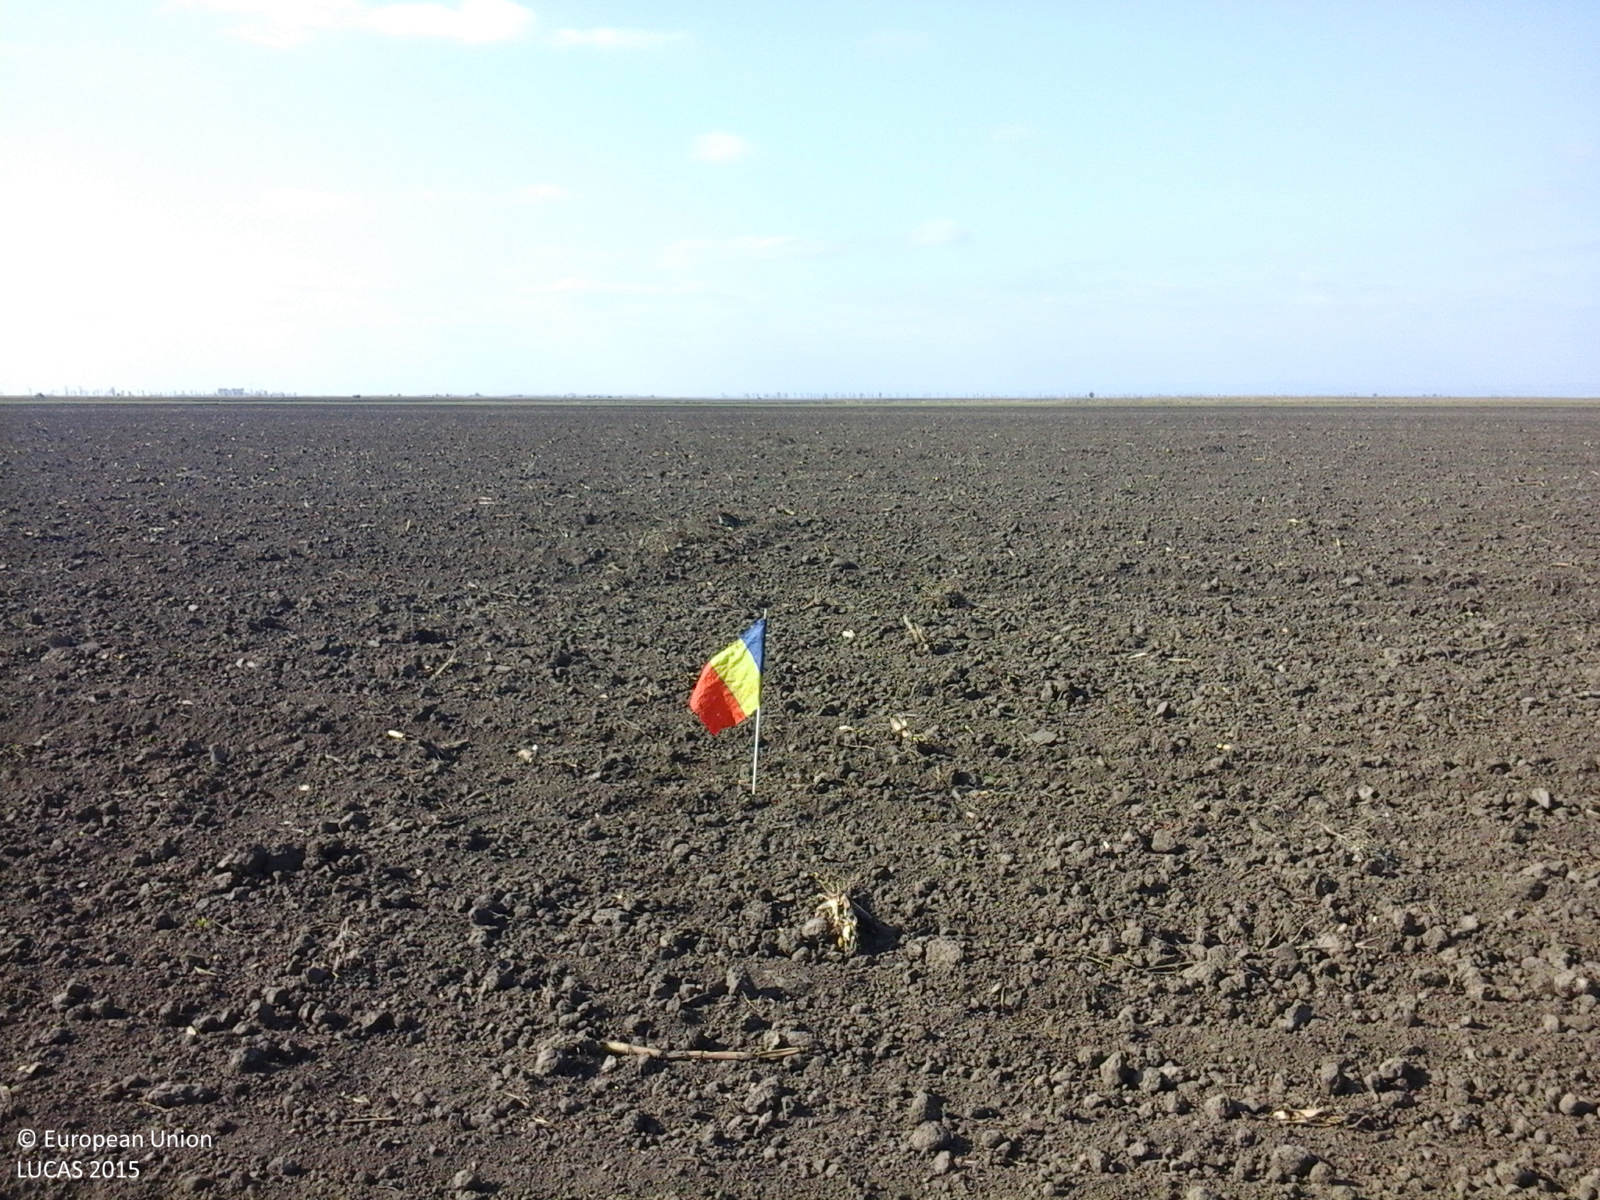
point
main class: Cropland
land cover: Common wheat
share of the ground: < 10 %
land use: Agriculture (excluding fallow land and kitchen gardens)
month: October
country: RO
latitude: 45.2173
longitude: 27.2189
